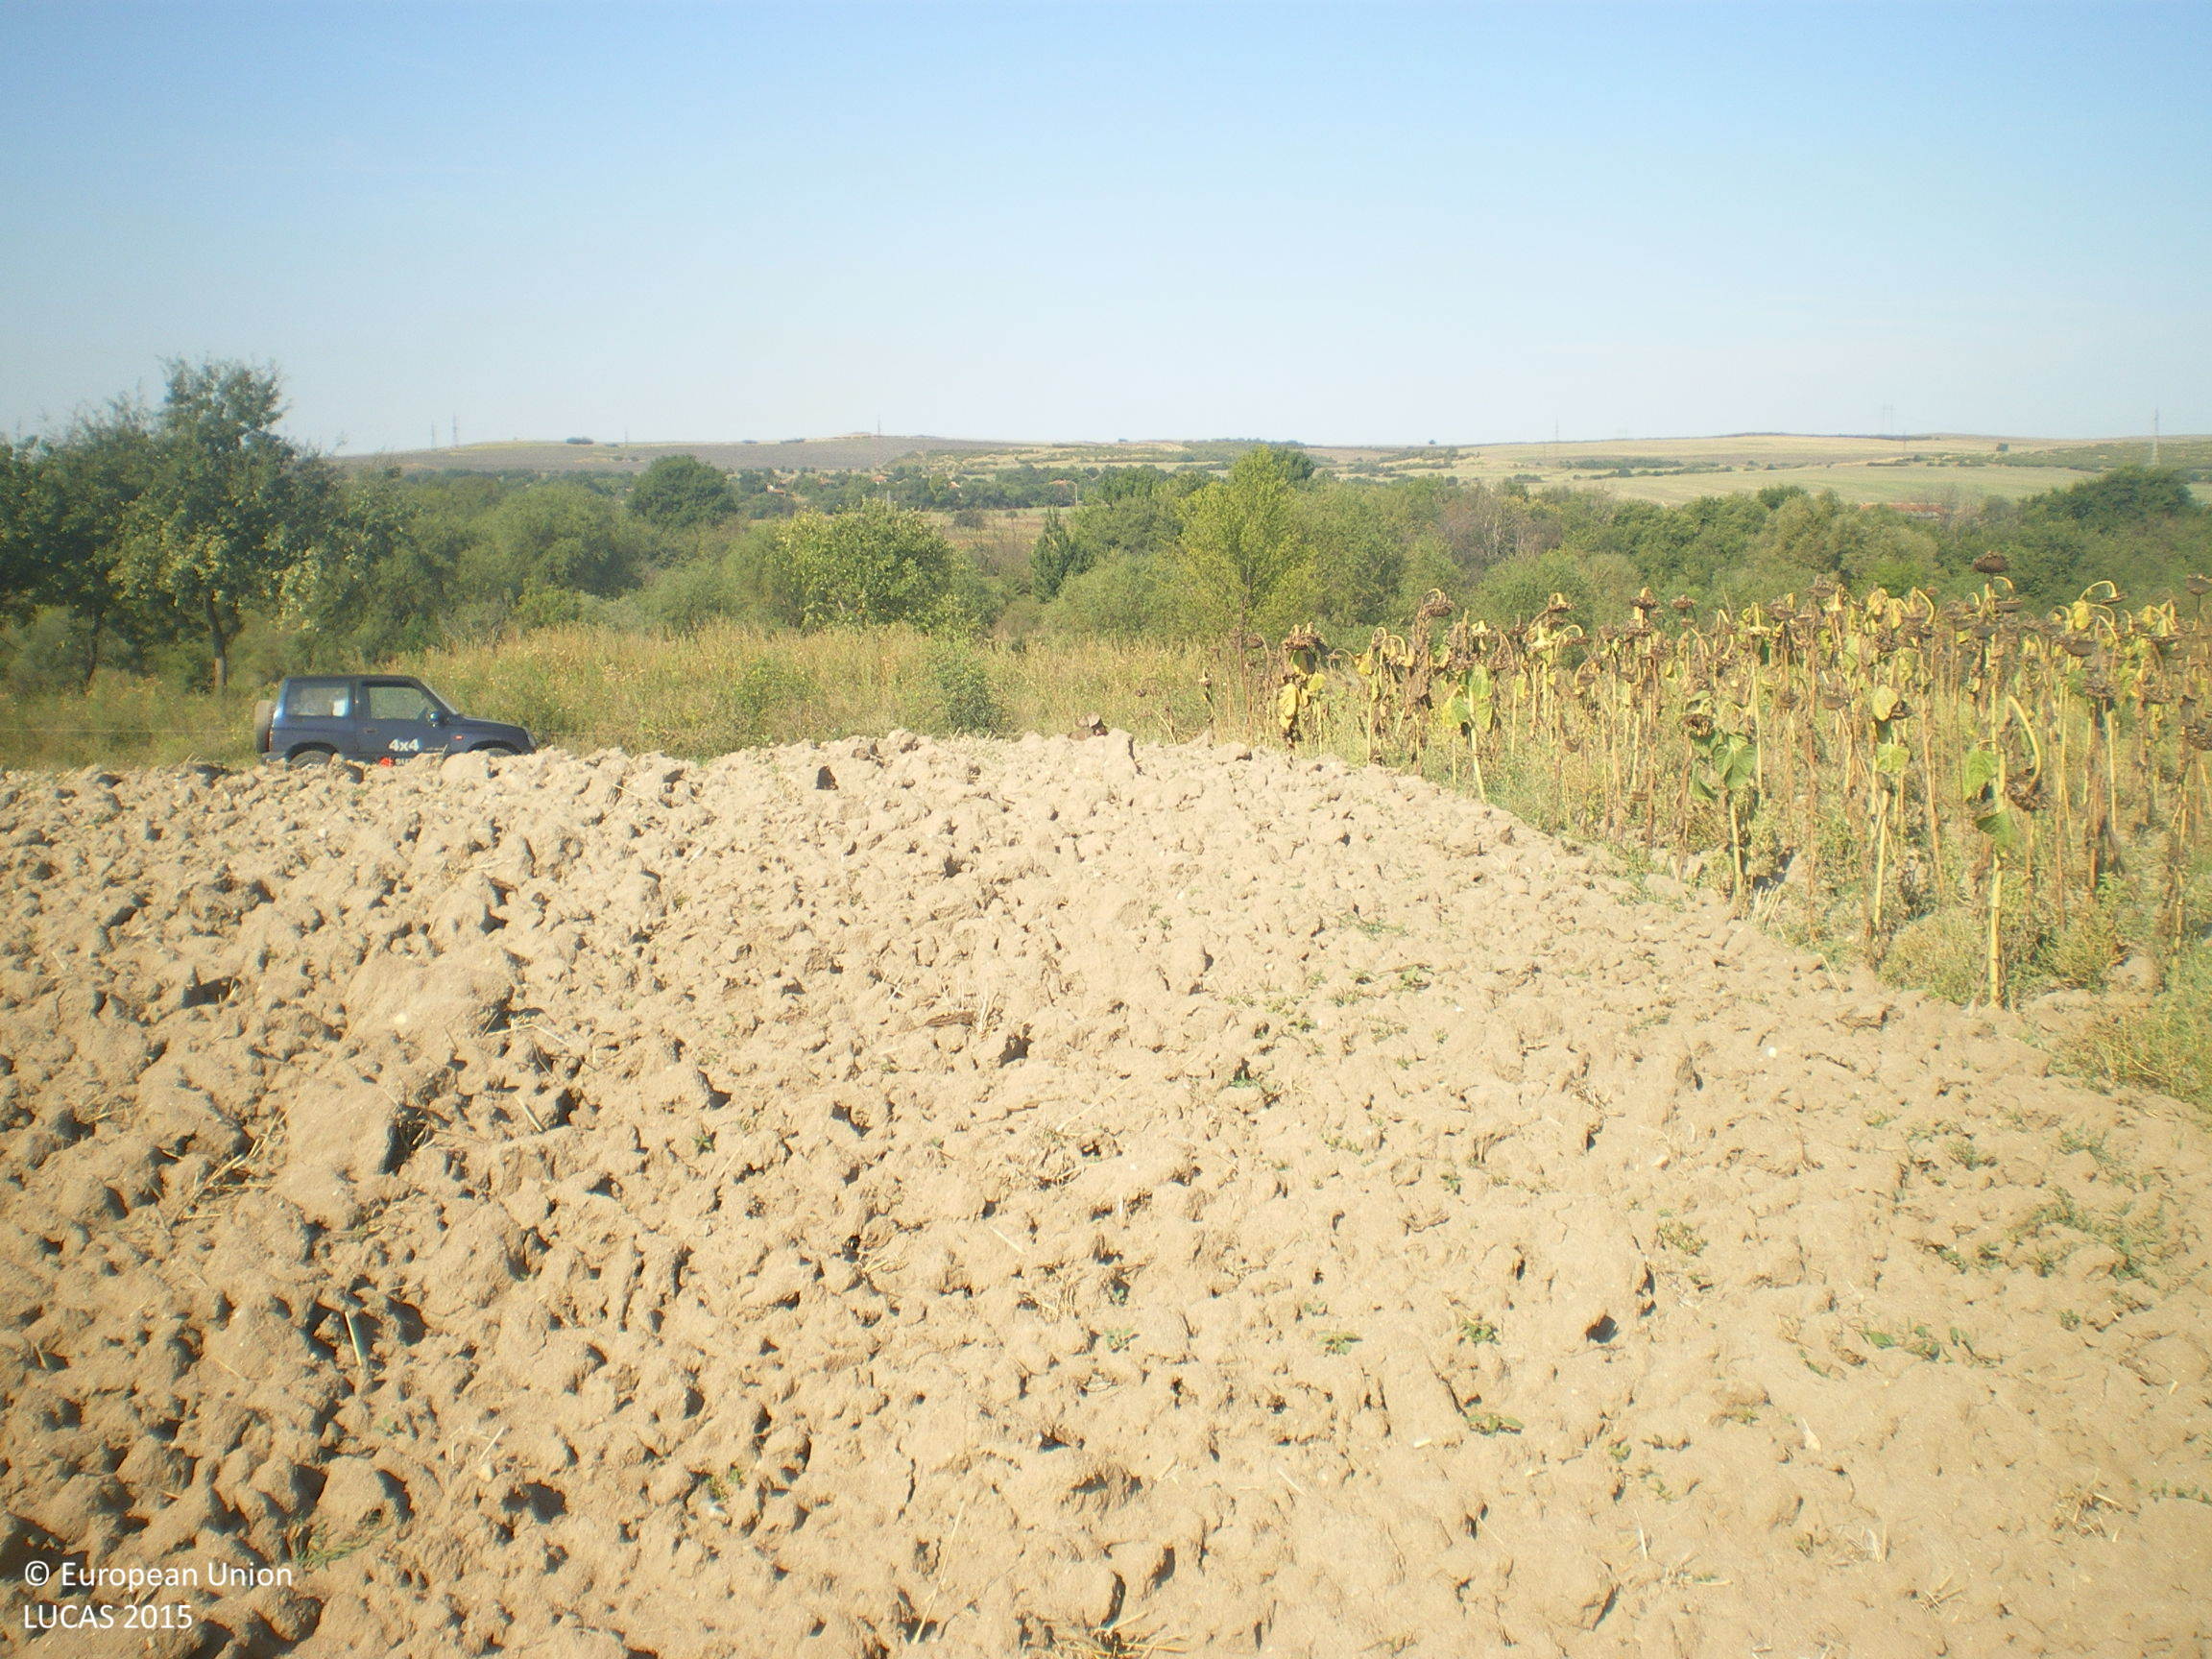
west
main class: Cropland
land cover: Common wheat
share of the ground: < 10 %
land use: Agriculture (excluding fallow land and kitchen gardens)
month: September
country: BG
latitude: 42.1085
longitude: 25.8792
